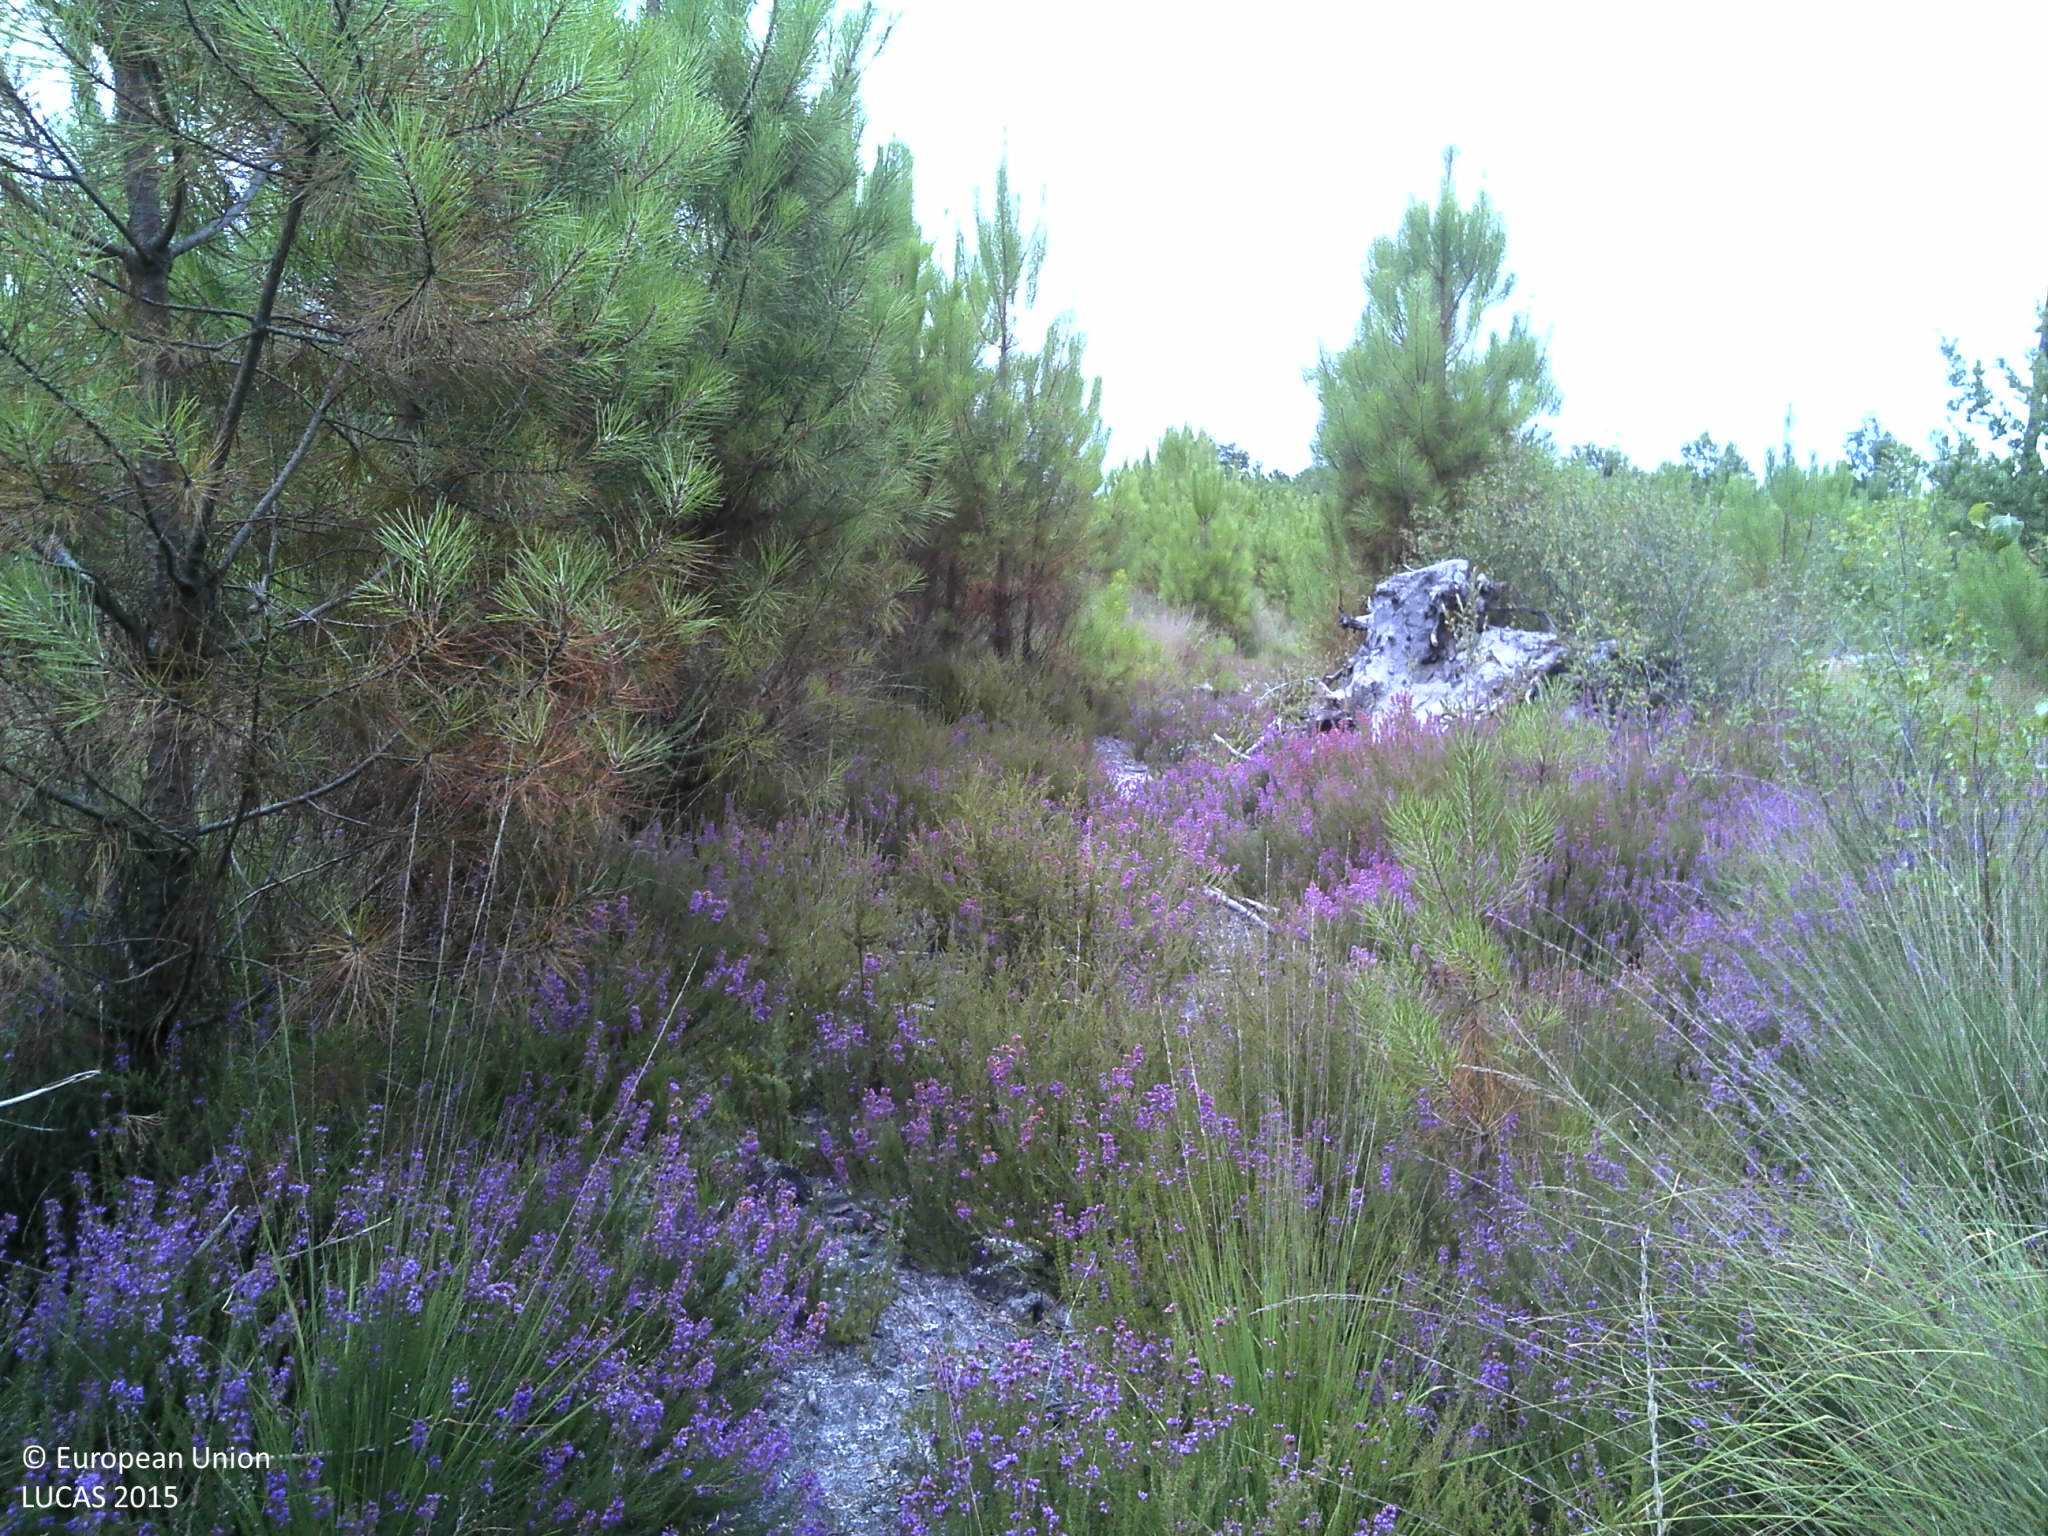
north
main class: Woodland
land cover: Pine dominated coniferous woodland
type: coniferous forest of the mediterranean region
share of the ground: 50 - 75 %
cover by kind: coniferous forest trees 60 %, shrubs 30 %, herbaceous plants 5 %, lichens and mosses 5 %
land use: Forestry
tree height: > 5 m
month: July
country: FR
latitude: 44.4948
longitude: -0.4406
